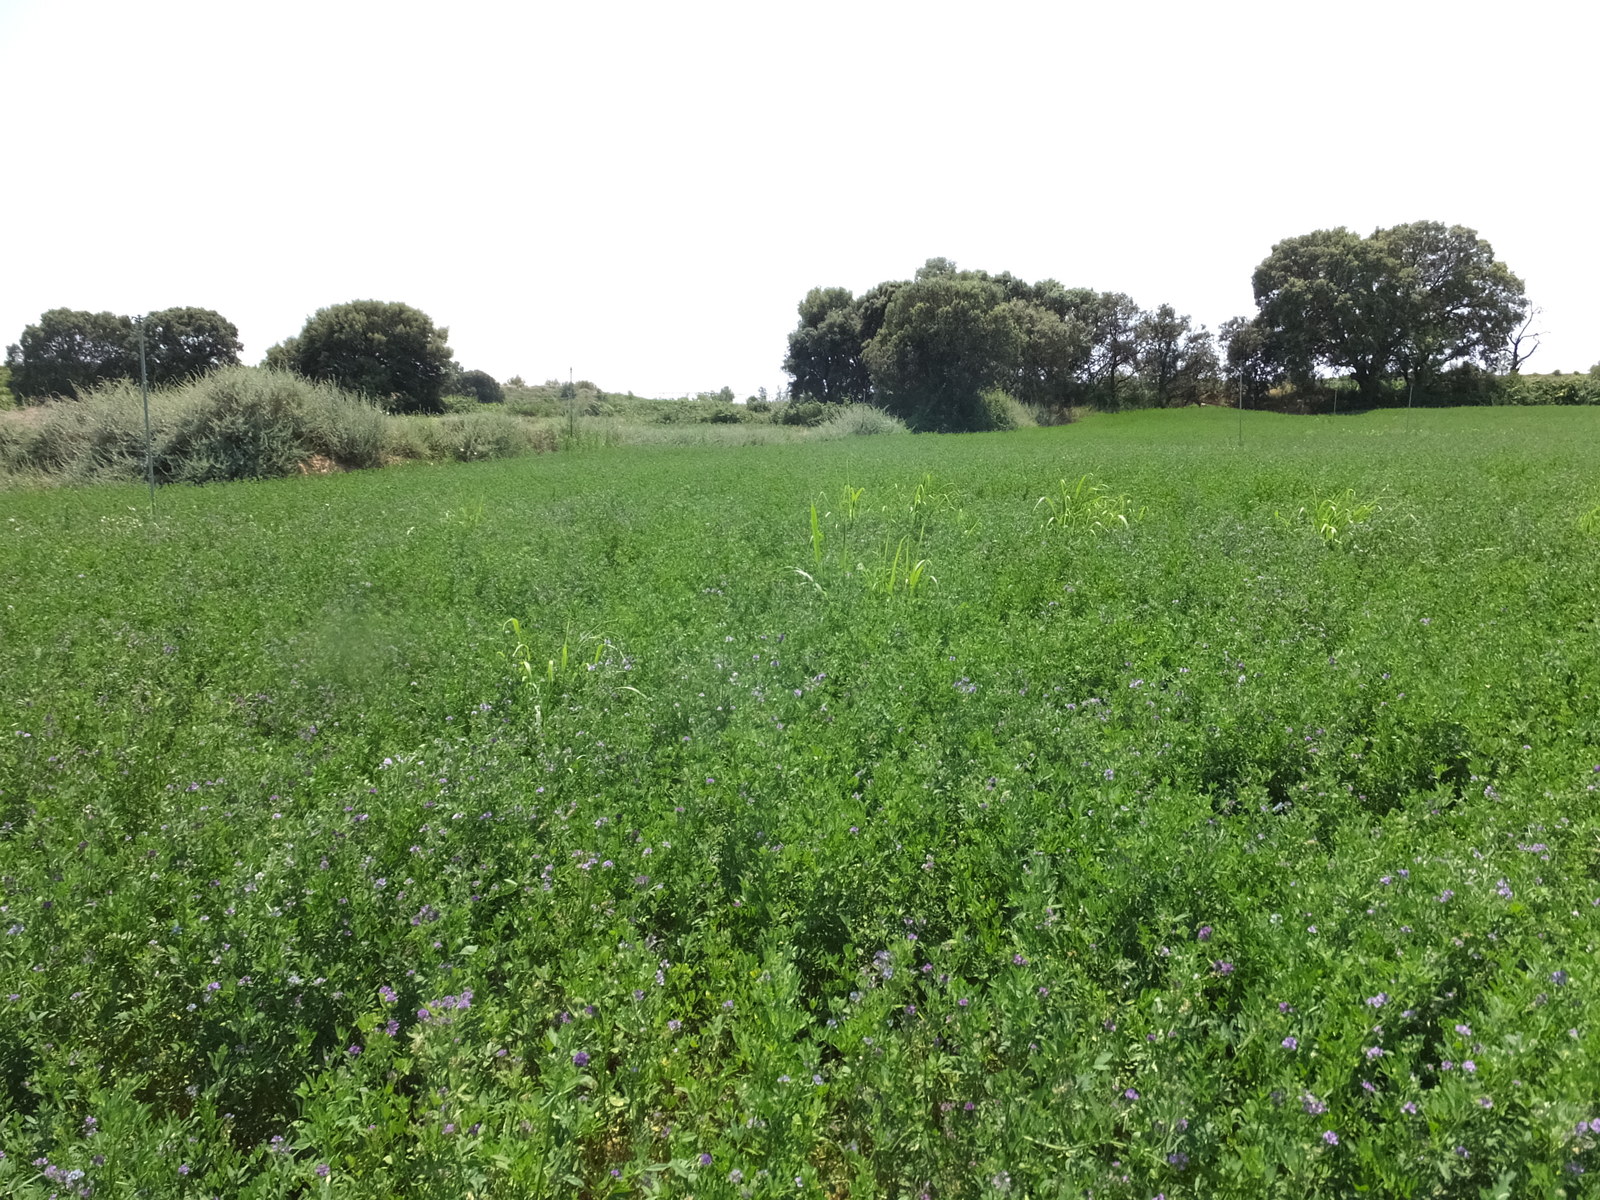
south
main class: Cropland
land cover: Lucerne
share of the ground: > 75 %
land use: Agriculture (excluding fallow land and kitchen gardens)
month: June
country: ES
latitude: 41.8161
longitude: 0.2211
